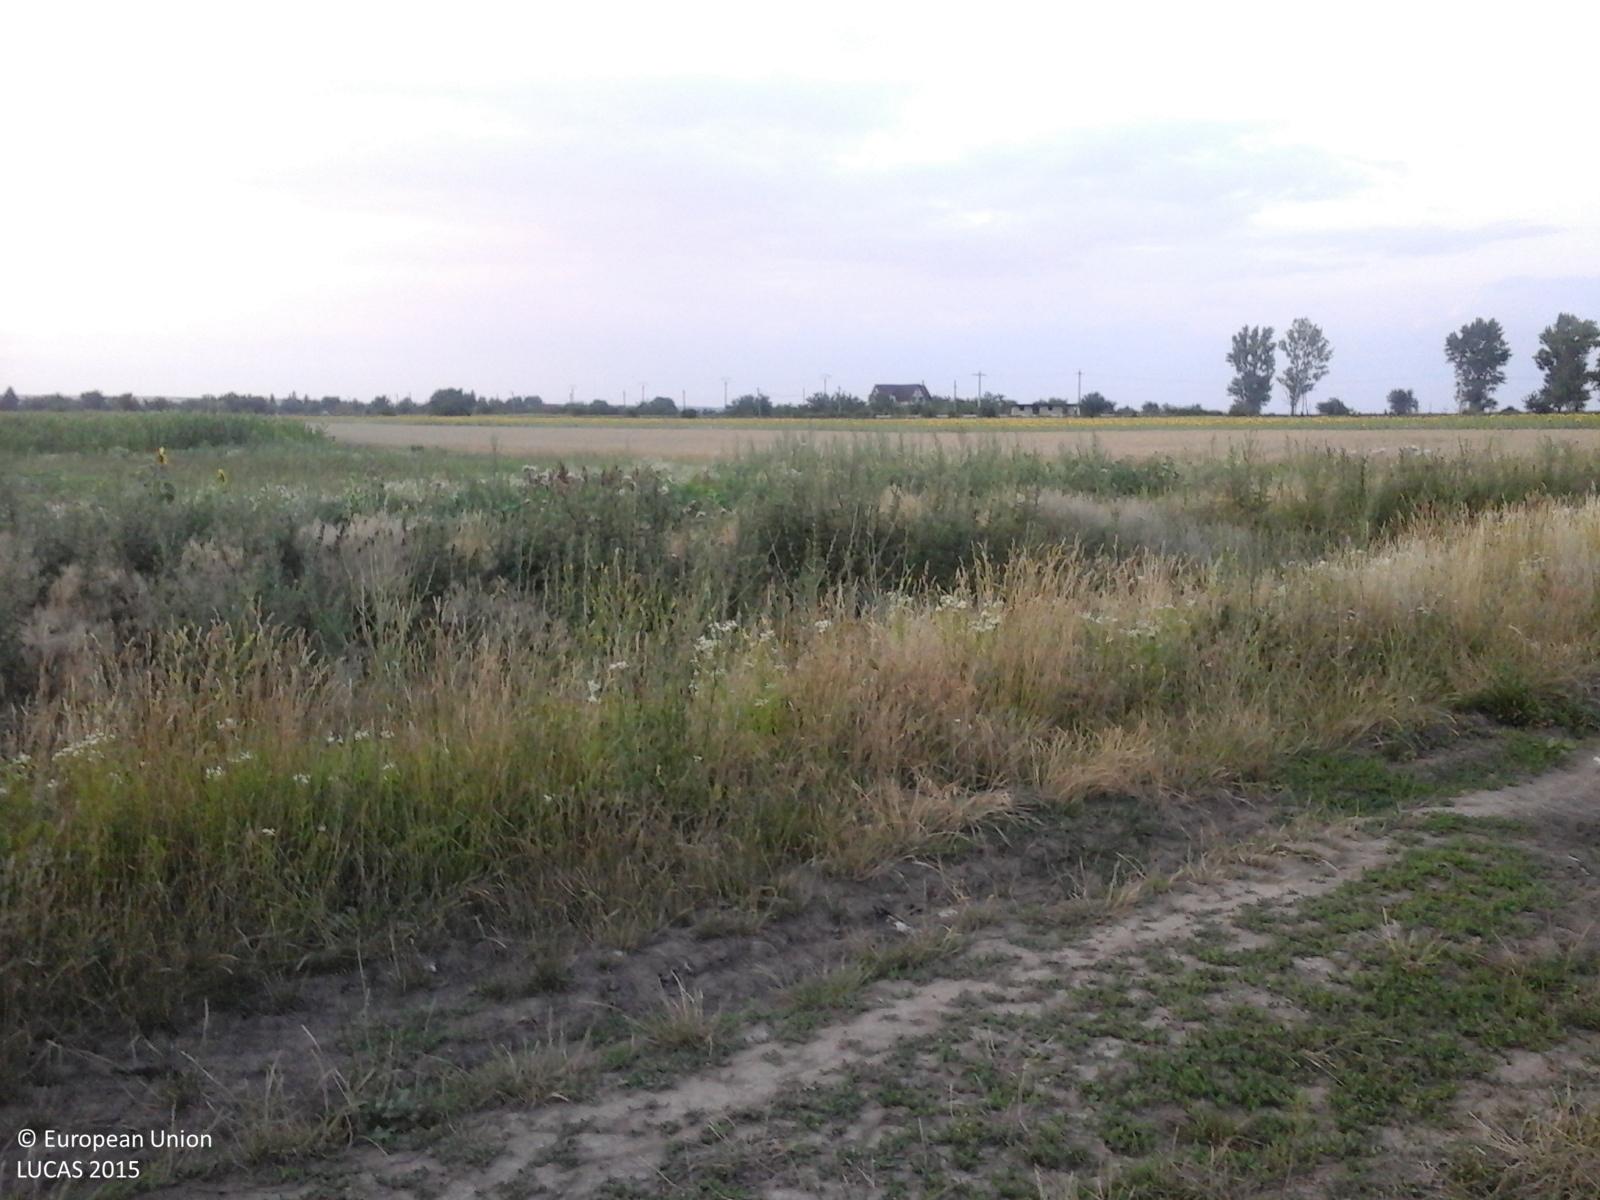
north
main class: Cropland
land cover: Sunflower
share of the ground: > 75 %
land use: Agriculture (excluding fallow land and kitchen gardens)
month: July
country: RO
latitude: 43.9327
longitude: 25.9539
